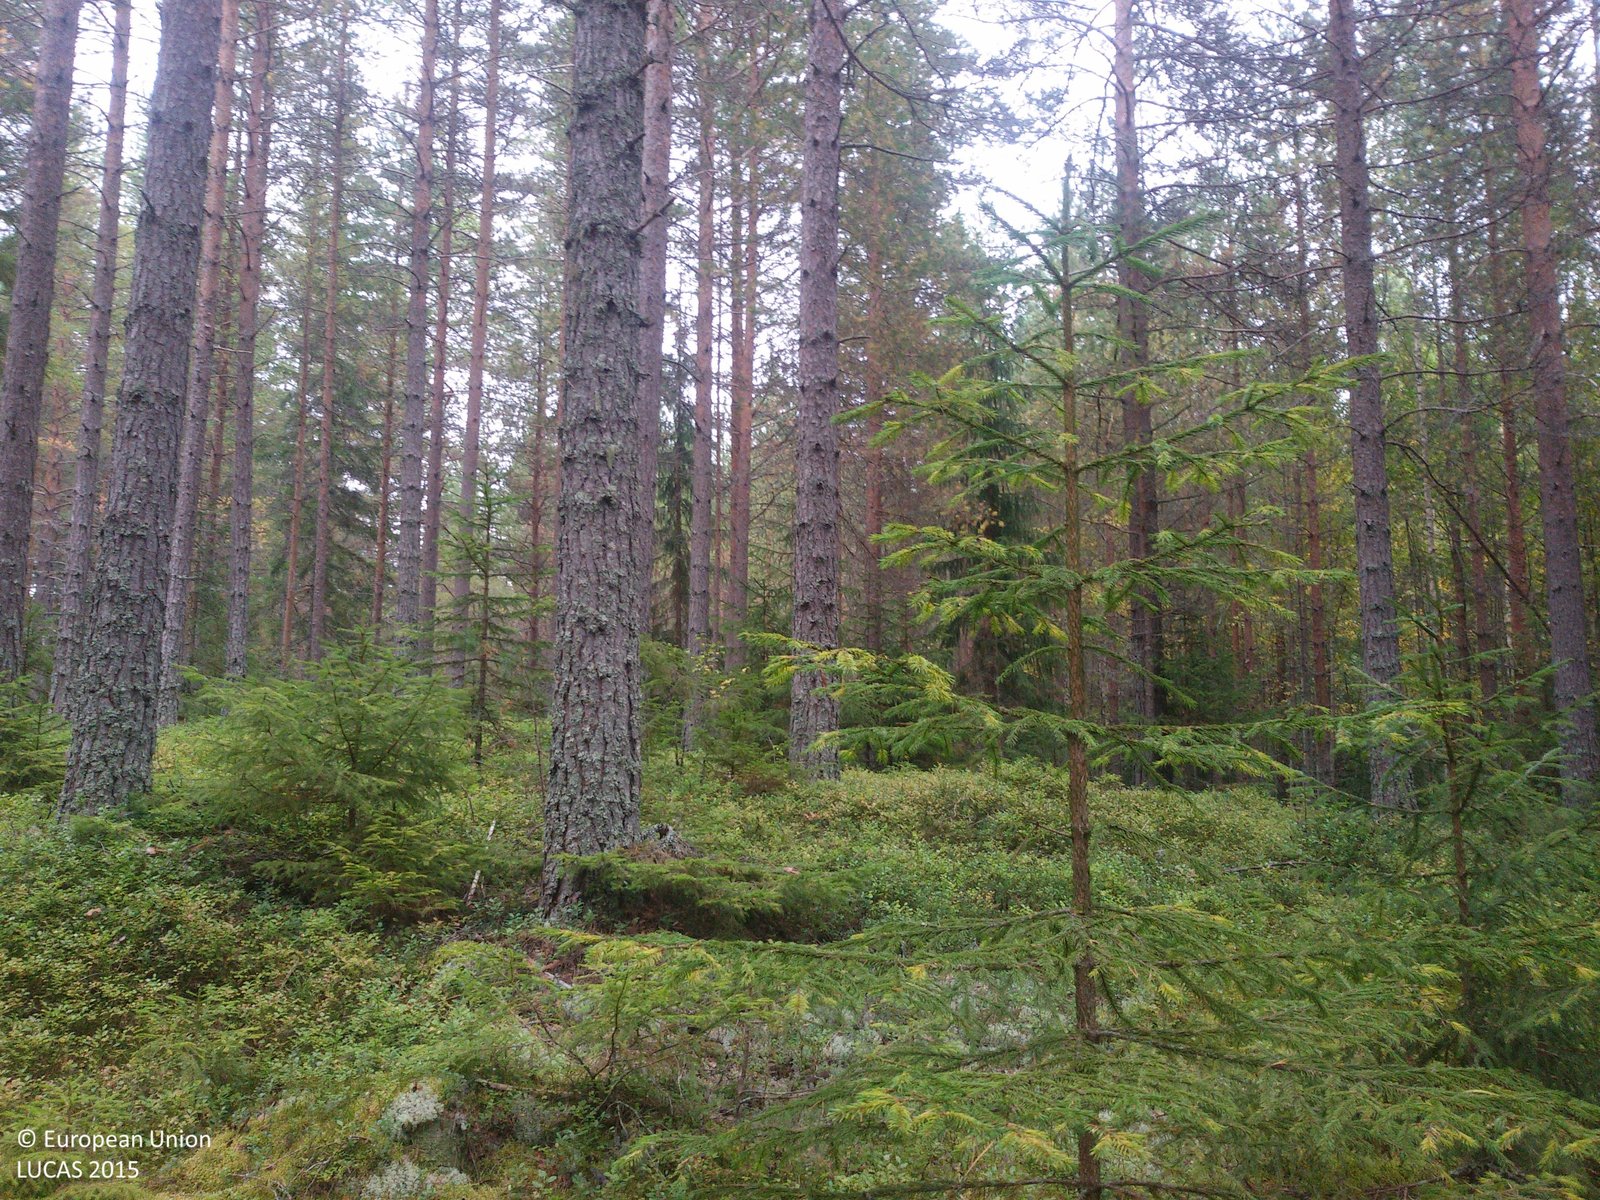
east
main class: Woodland
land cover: Pine dominated coniferous woodland
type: boreal forest
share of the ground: > 75 %
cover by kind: coniferous forest trees 75 %, shrubs 15 %, lichens and mosses 10 %
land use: Forestry
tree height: > 5 m
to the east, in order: Pine dominated coniferous woodland; Spruce dominated mixed woodland; Pine dominated coniferous woodland
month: September
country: SE
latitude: 61.0709
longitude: 14.3047
